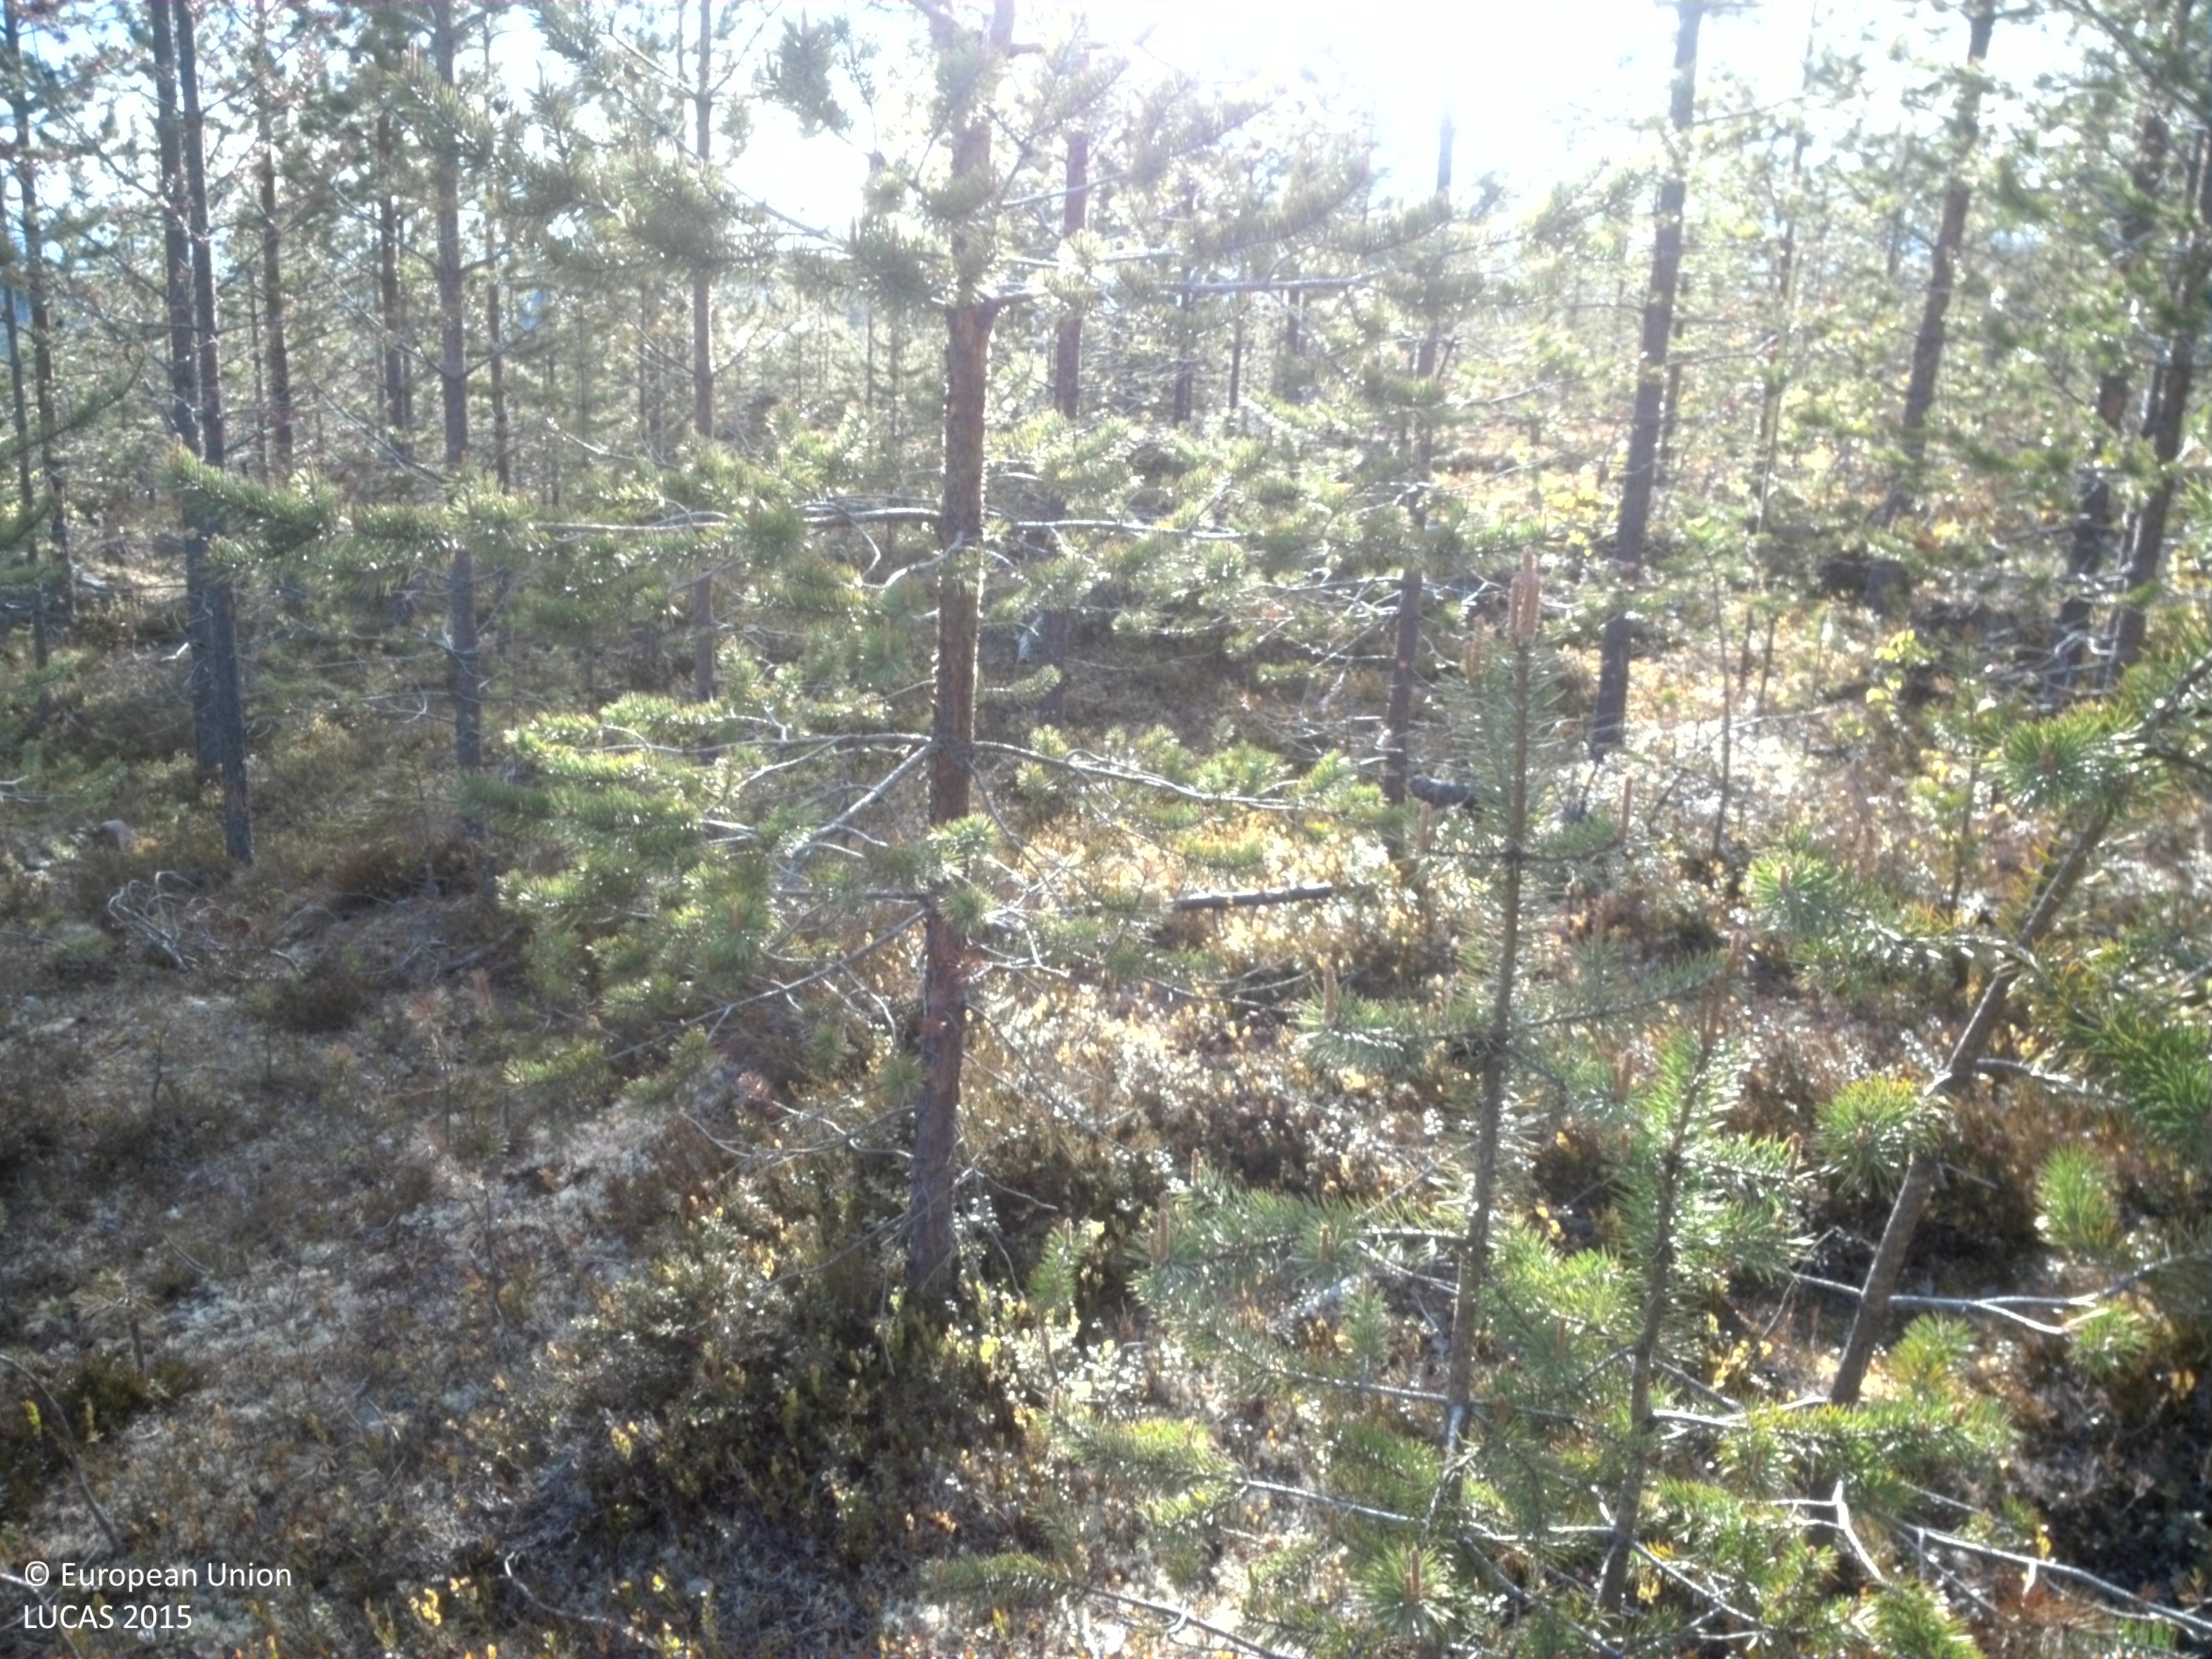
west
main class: Woodland
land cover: Pine dominated coniferous woodland
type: boreal forest
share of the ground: 25 - 50 %
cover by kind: shrubs 45 %, coniferous forest trees 40 %, lichens and mosses 15 %
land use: Forestry
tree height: > 5 m
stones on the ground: 10 - 25 %
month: June
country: SE
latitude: 66.9114
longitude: 22.0041
